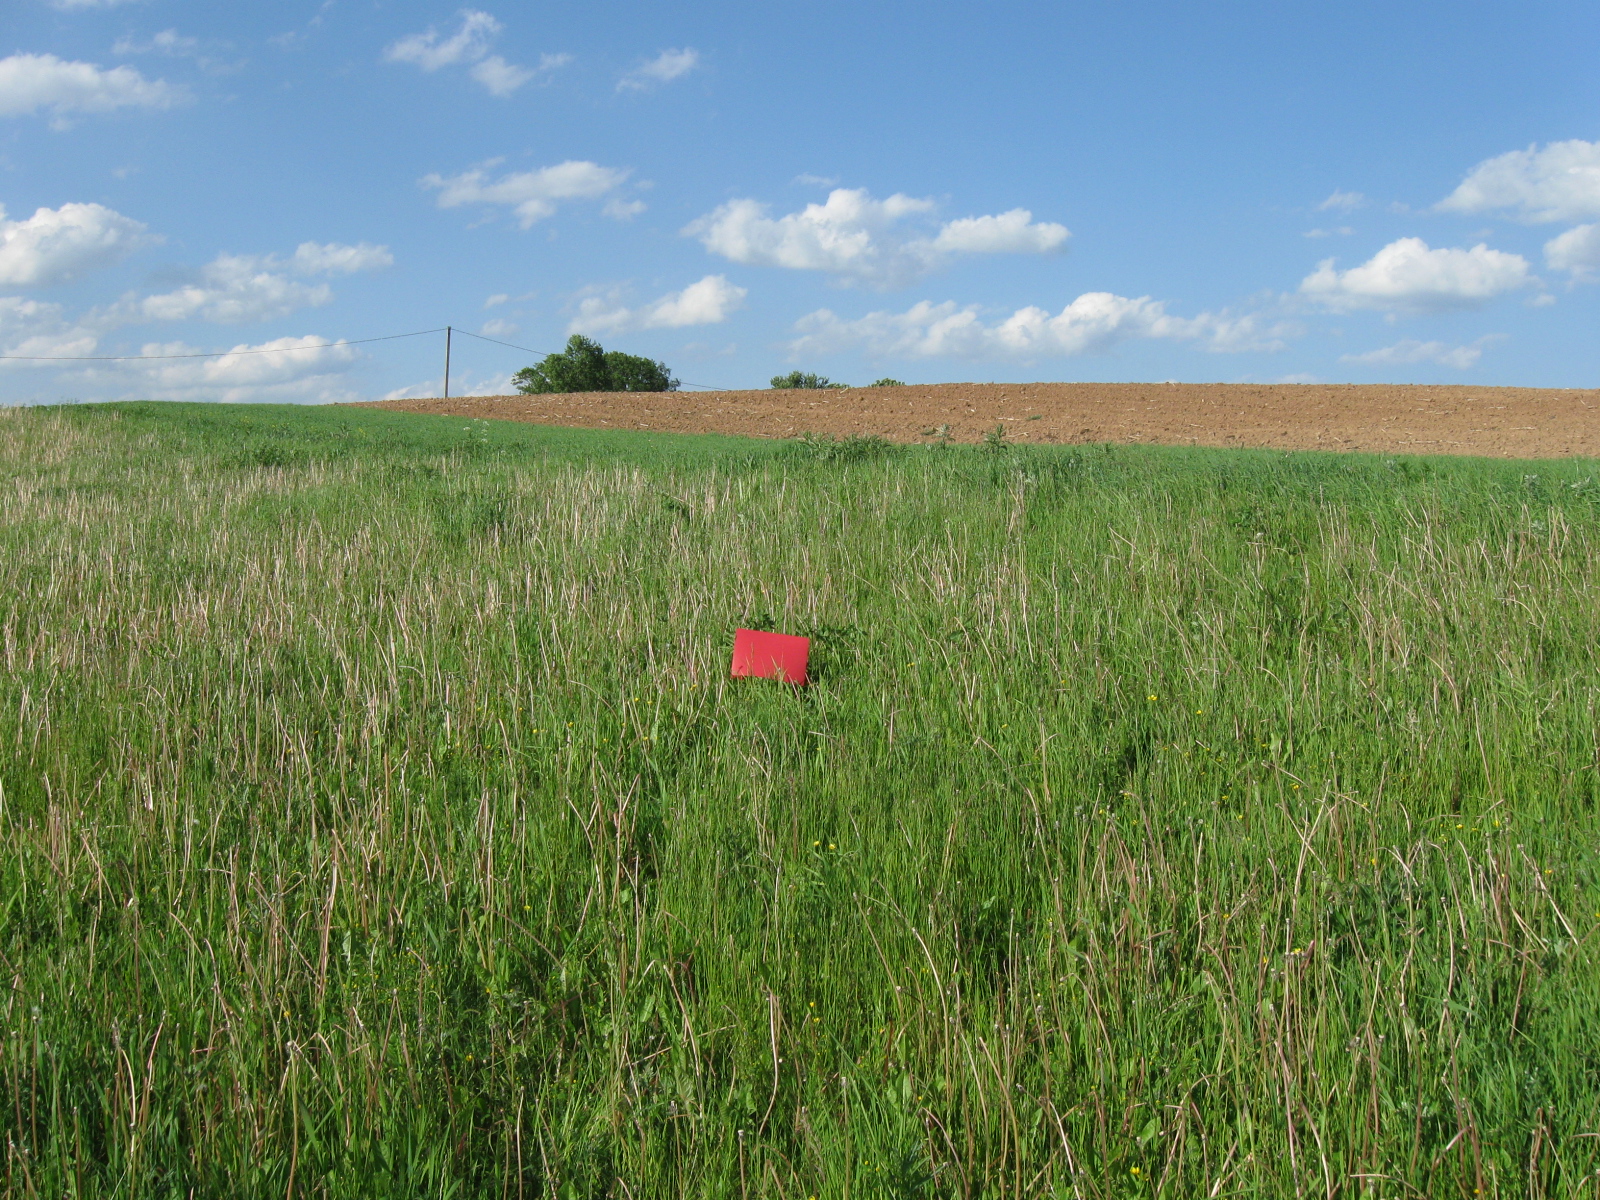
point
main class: Grassland
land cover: Grassland without tree/shrub cover
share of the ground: > 75 %
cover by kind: herbaceous plants 100 %
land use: Agriculture (excluding fallow land and kitchen gardens)
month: June
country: LT
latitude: 54.2398
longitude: 23.7278
